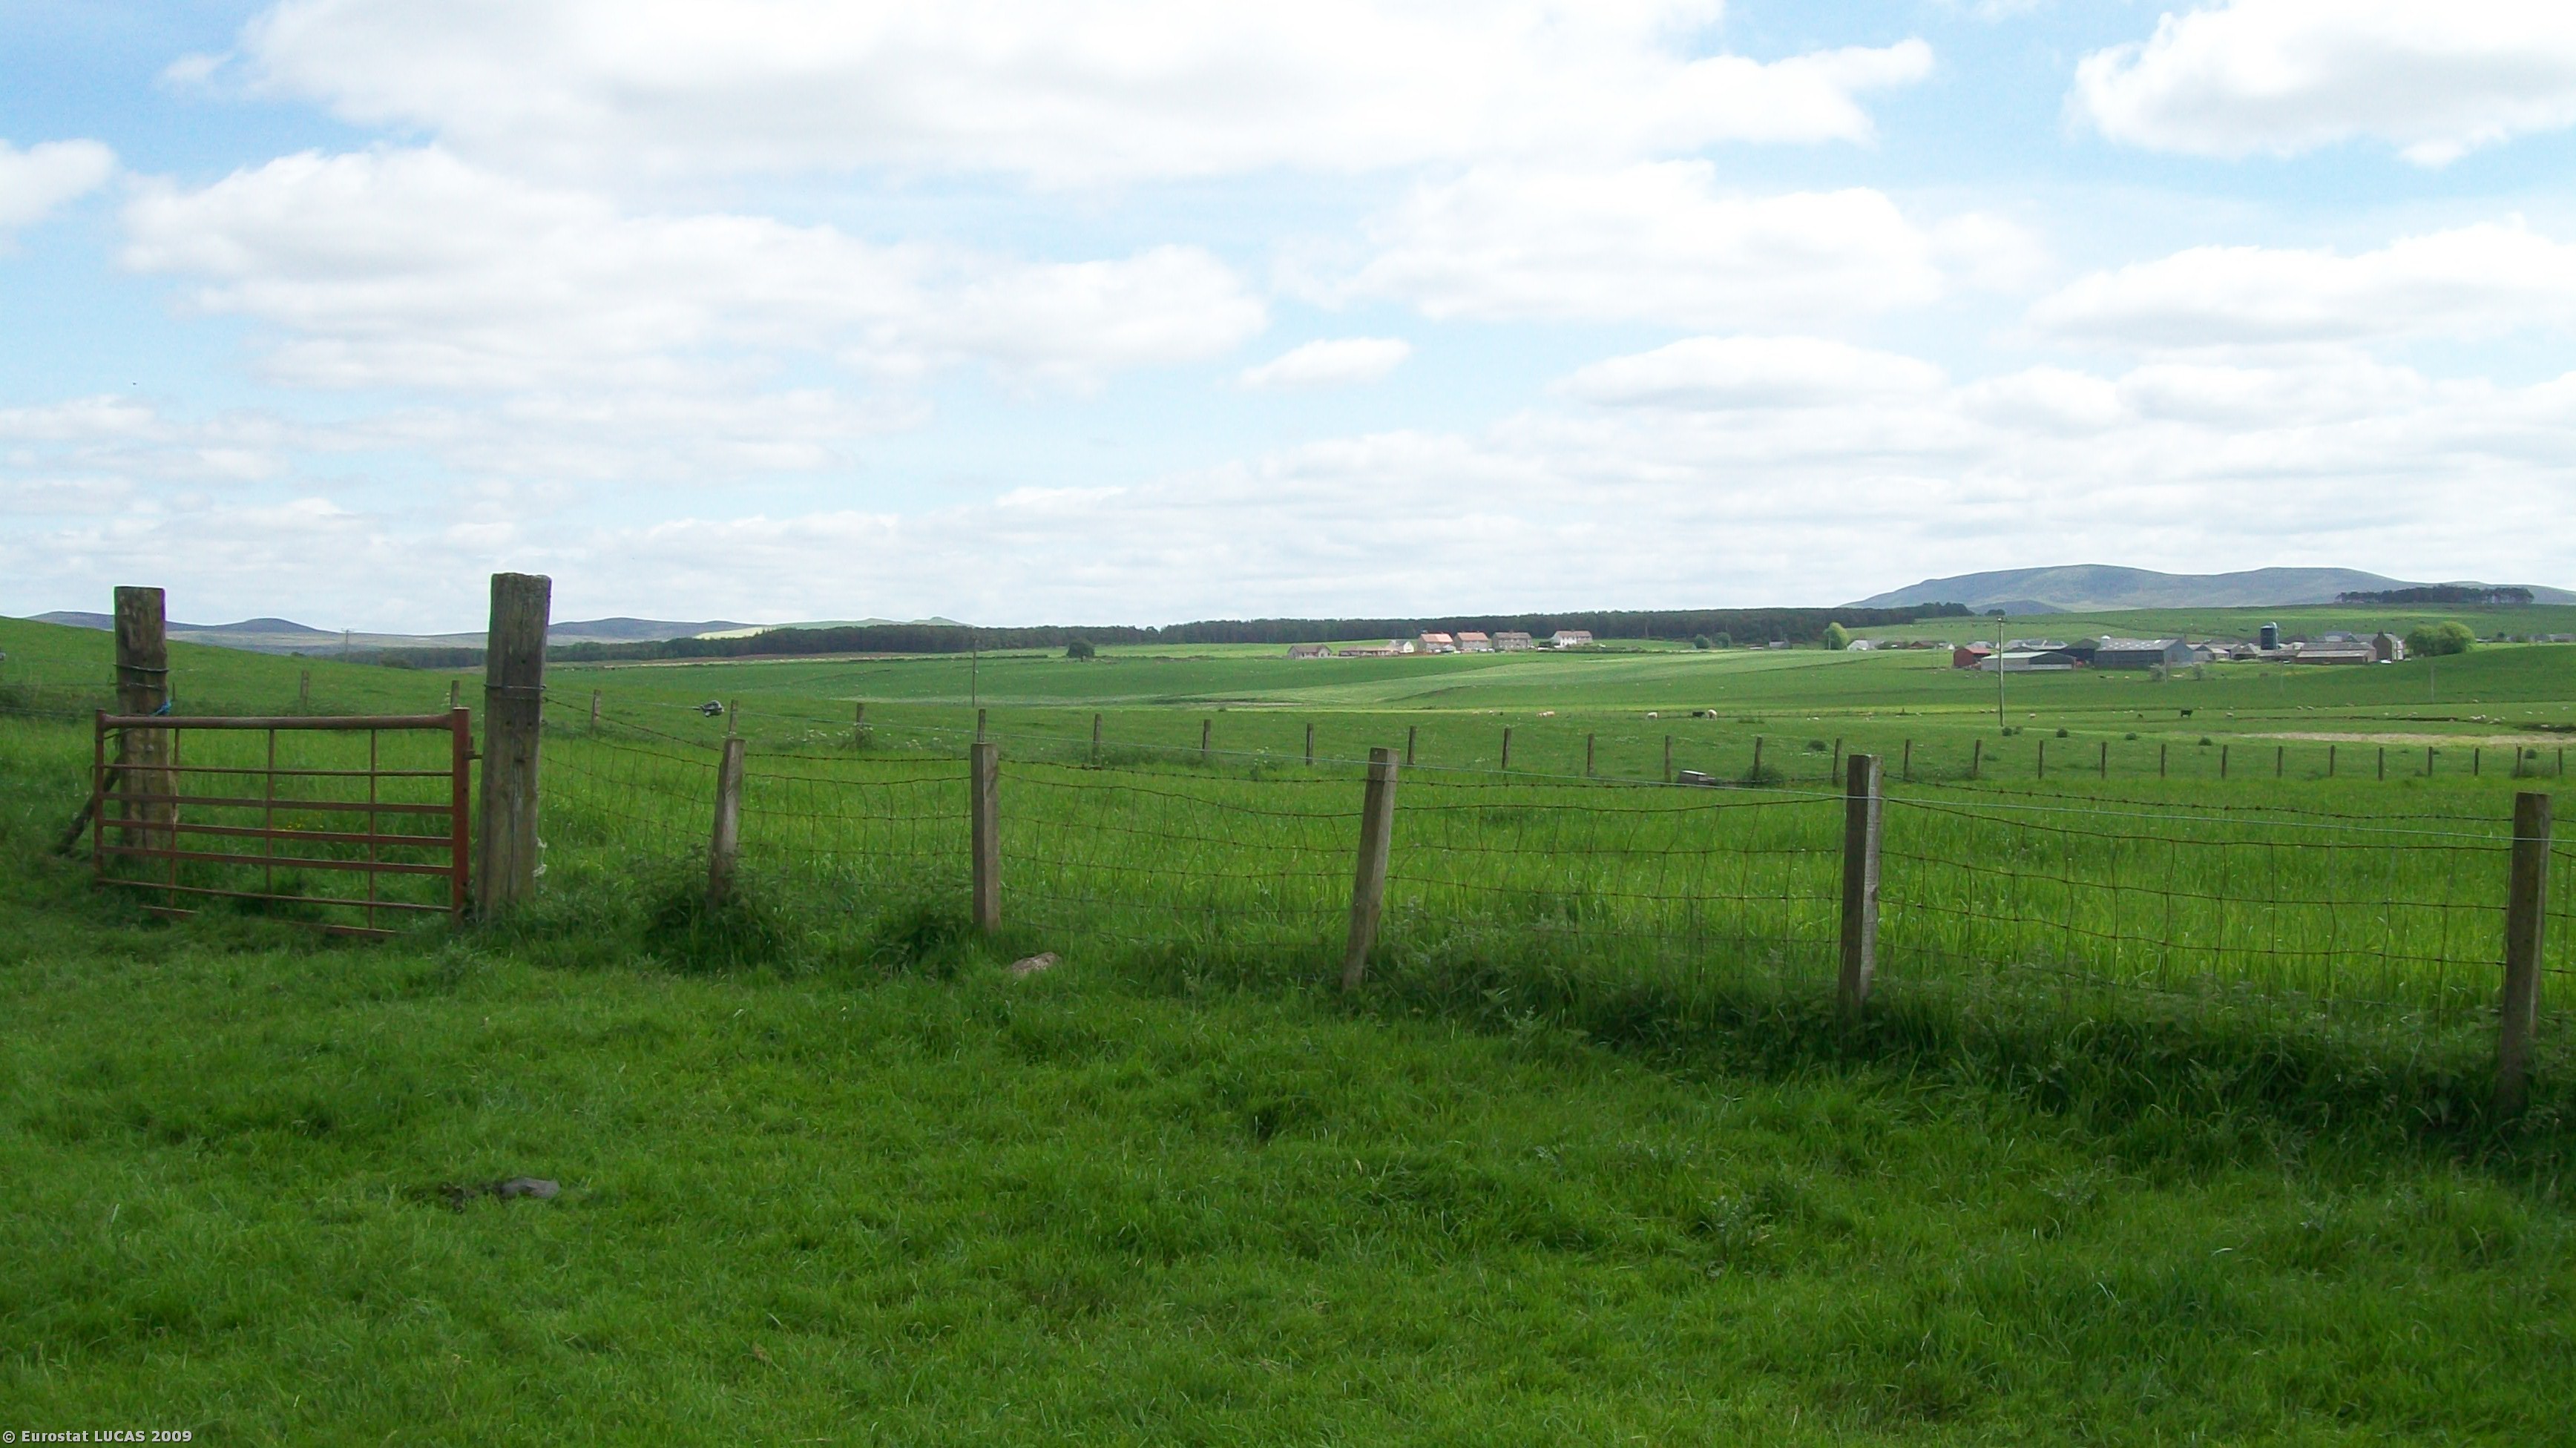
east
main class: Grassland
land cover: Grassland without tree/shrub cover
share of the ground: > 75 %
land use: Agriculture (excluding fallow land and kitchen gardens)
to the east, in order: Grassland without tree/shrub cover; Fences; Grassland without tree/shrub cover; Fences; Grassland without tree/shrub cover
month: June
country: GB
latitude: 55.6978
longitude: -3.5882
